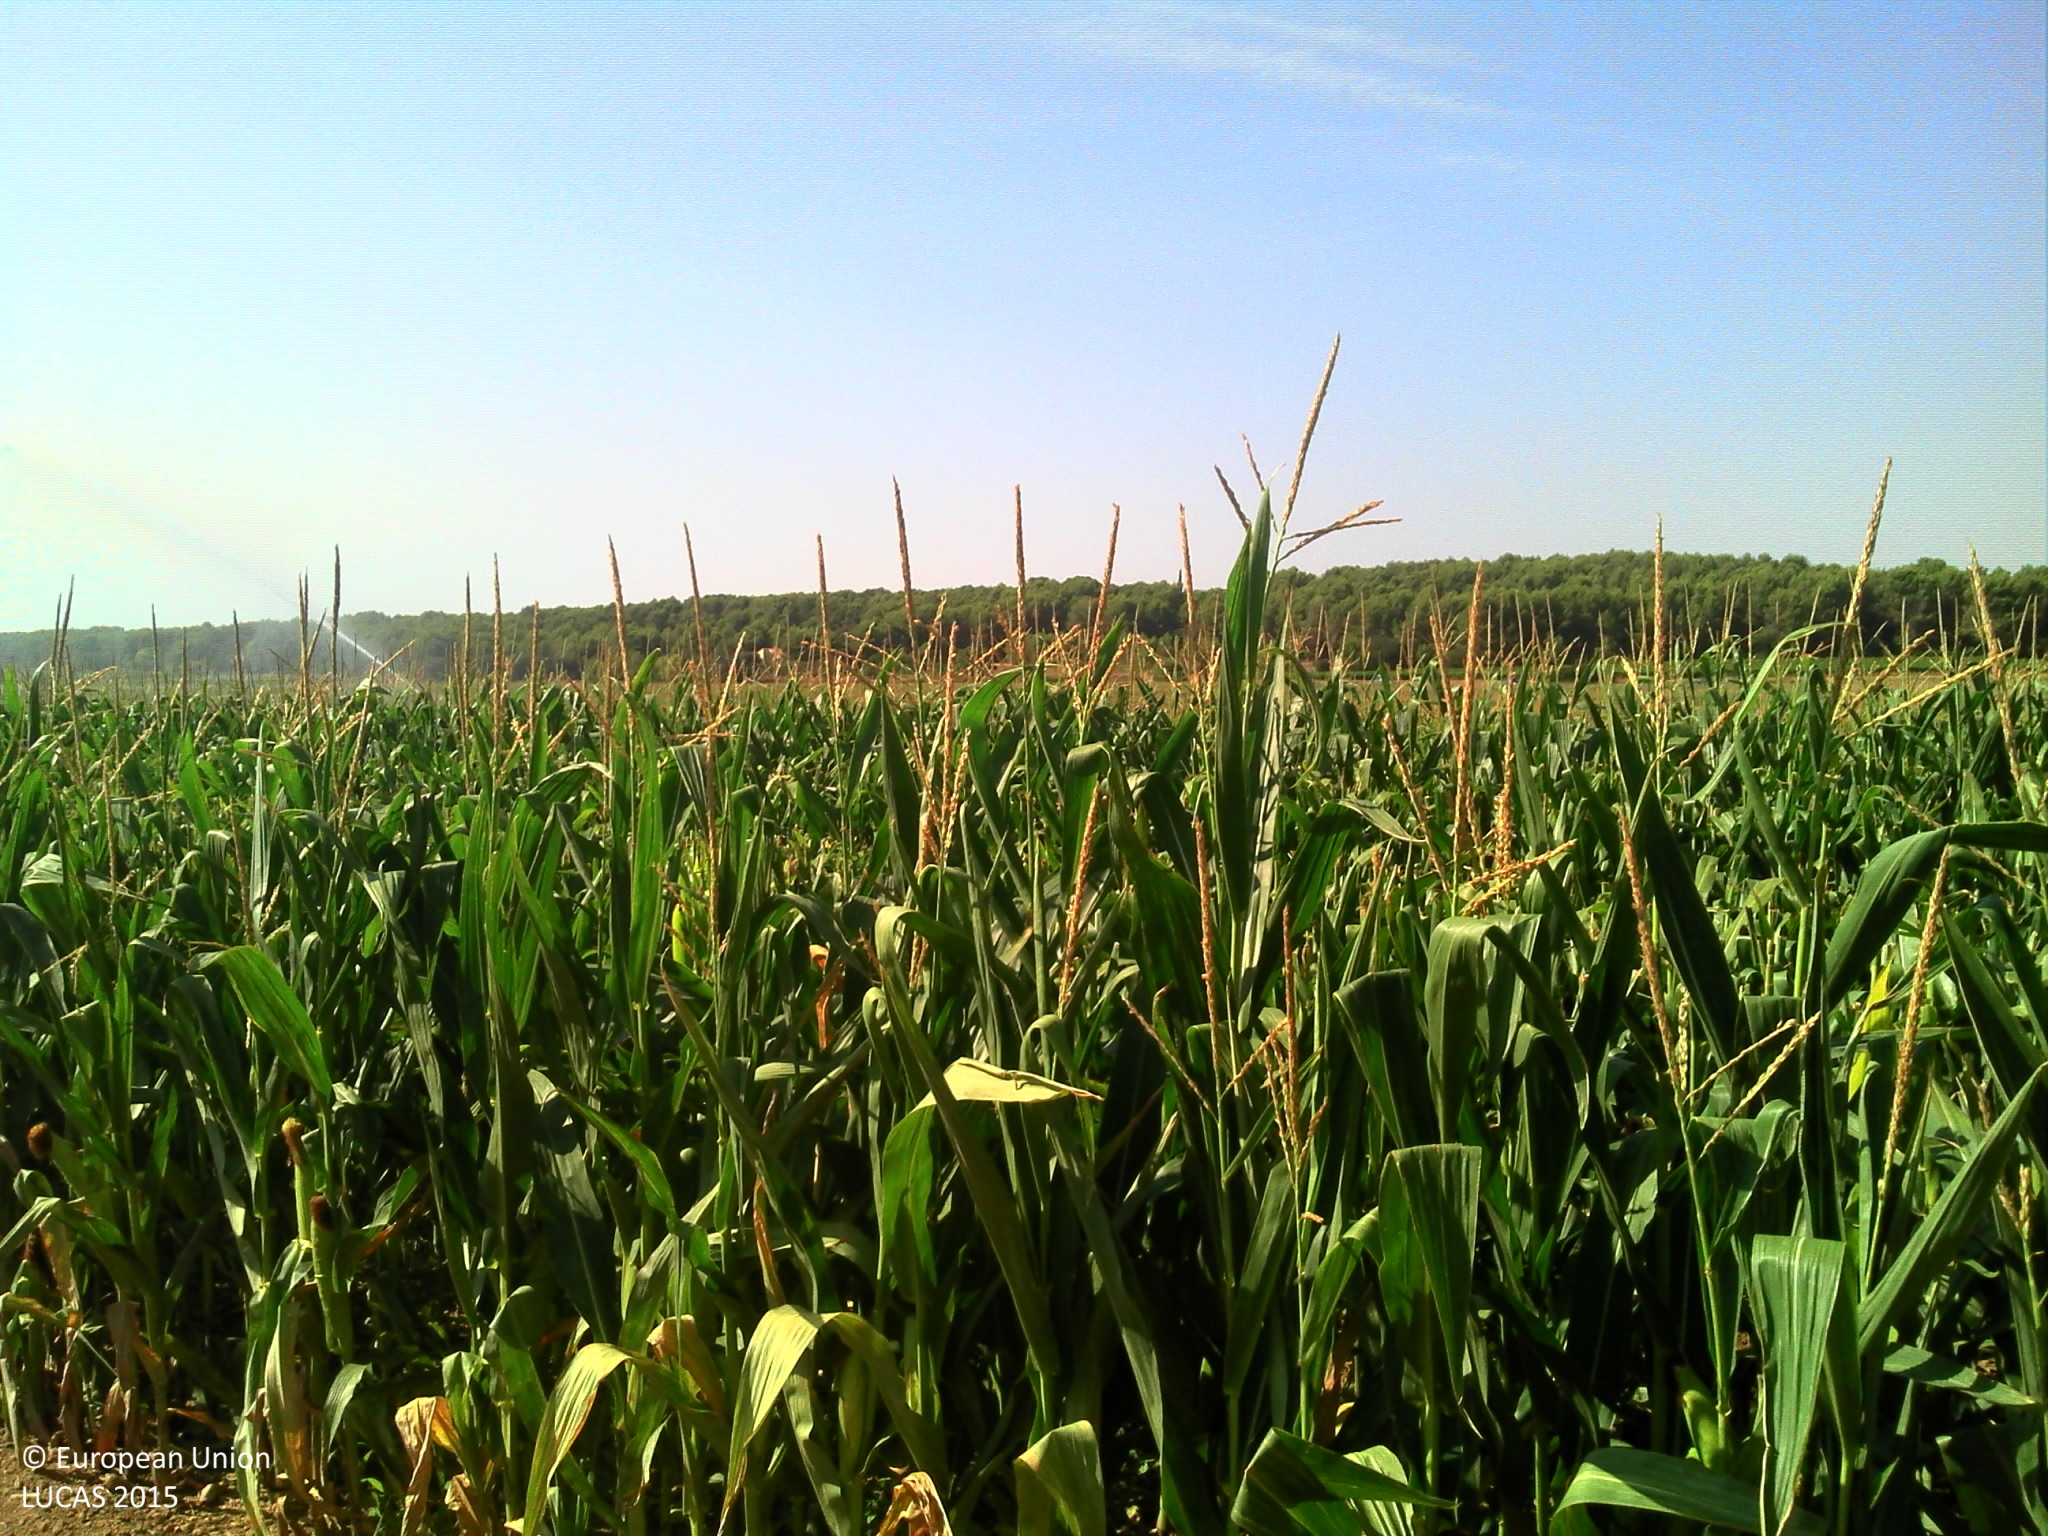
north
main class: Cropland
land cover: Maize
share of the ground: > 75 %
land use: Agriculture (excluding fallow land and kitchen gardens)
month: August
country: FR
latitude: 43.5774
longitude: 5.3411
